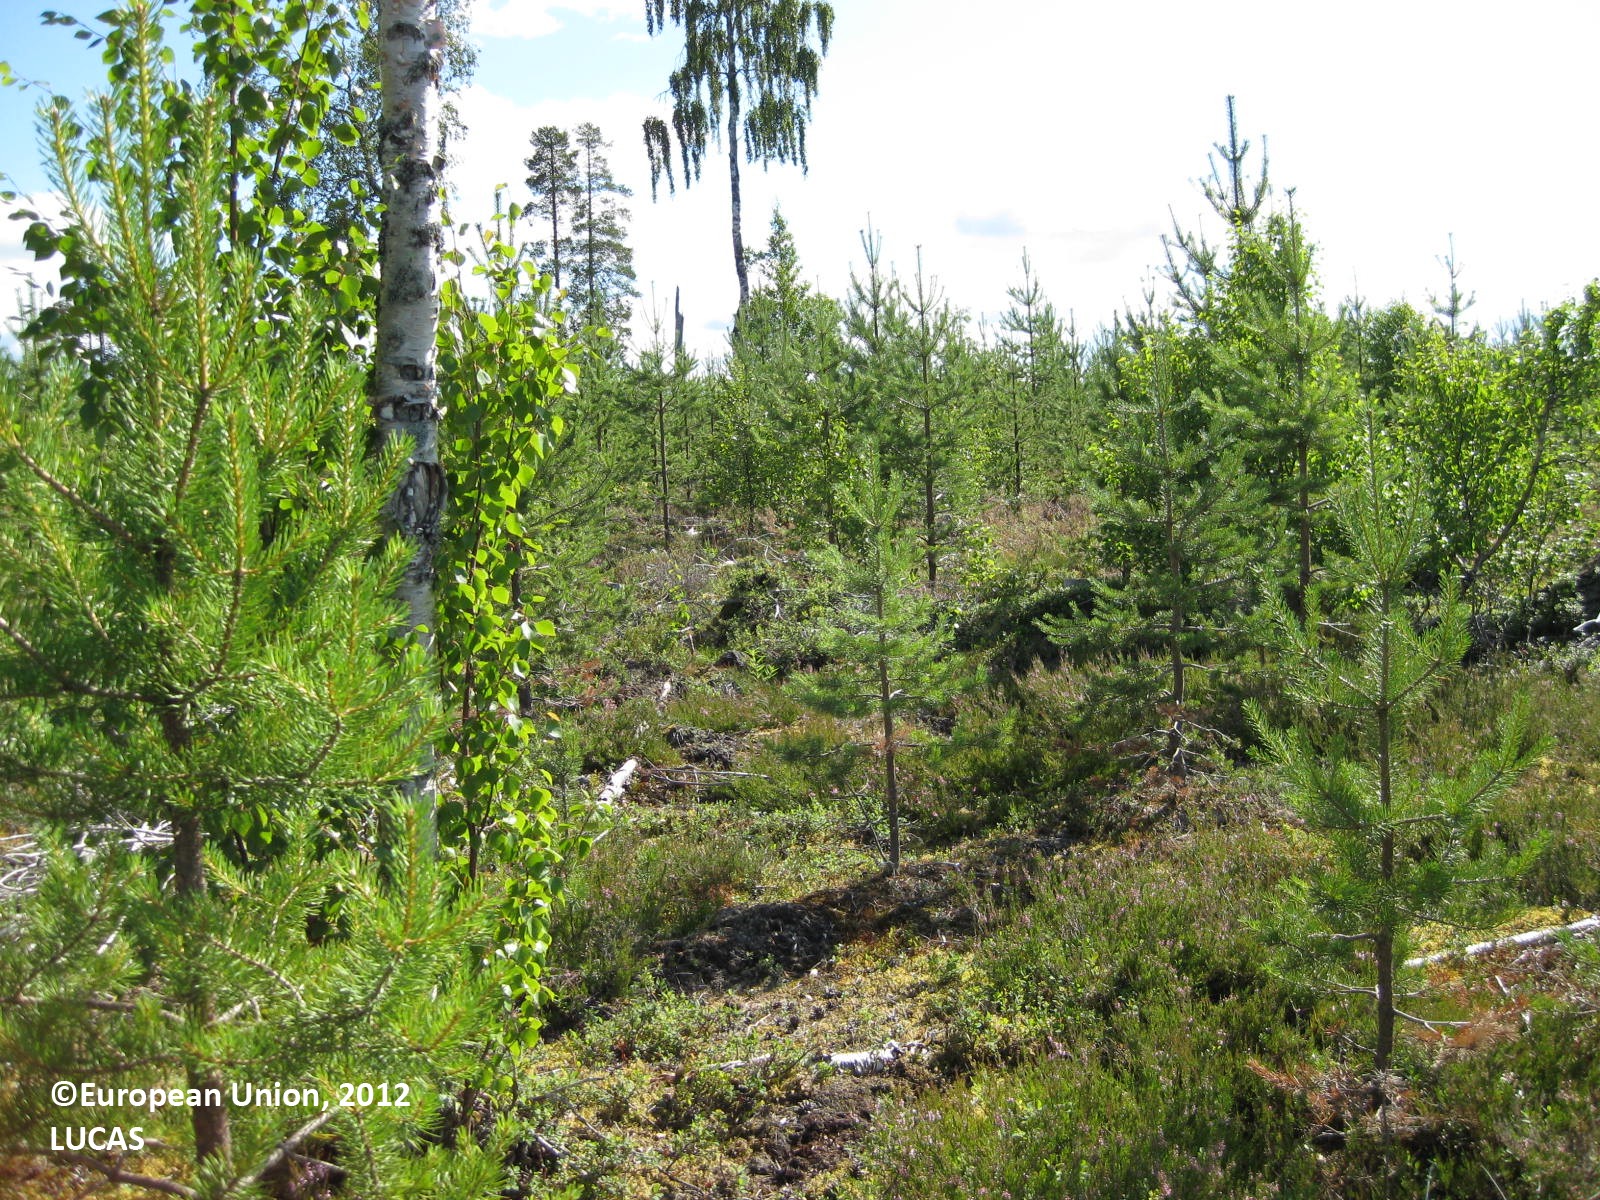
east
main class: Woodland
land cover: Pine dominated mixed woodland
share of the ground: 50 - 75 %
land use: Forestry
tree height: < 5 m
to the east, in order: Pine dominated mixed woodland; Pine dominated coniferous woodland; Tracks; Abandoned hedges; Ditches and canals; Pine dominated mixed woodland; Pine dominated coniferous woodland
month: July
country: FI
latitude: 65.6735
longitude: 28.4539
